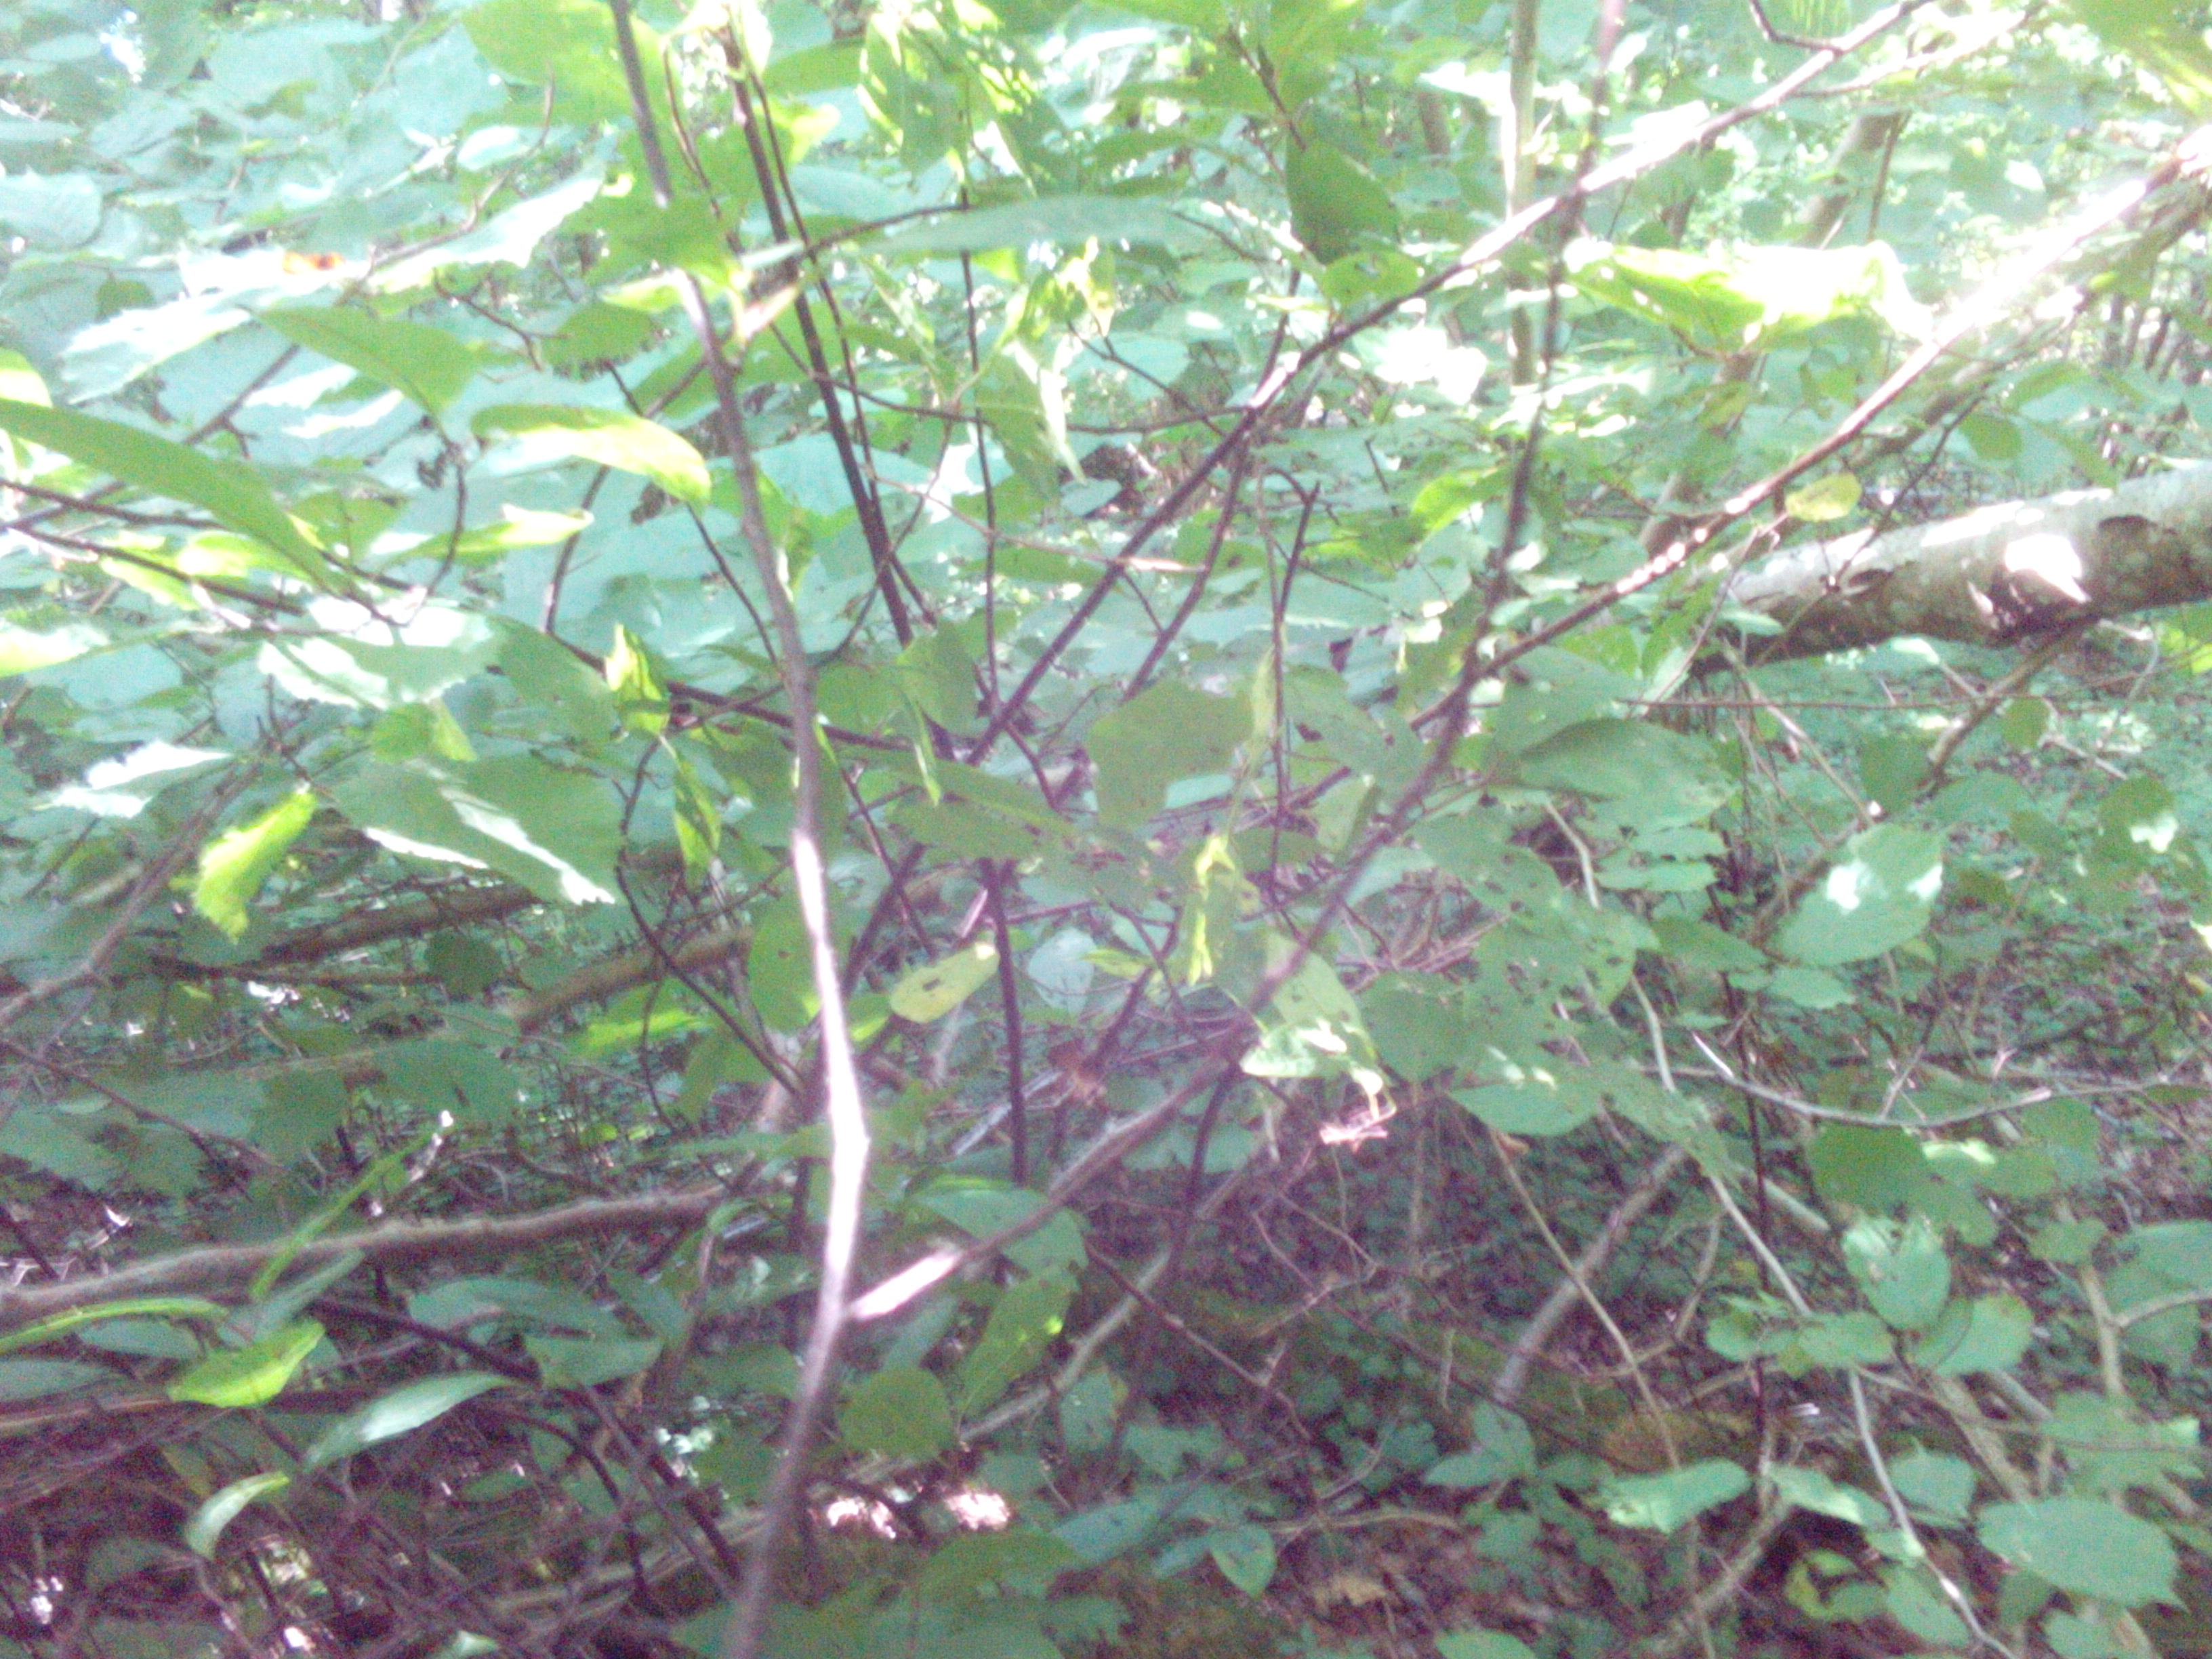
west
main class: Woodland
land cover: Broadleaved woodland
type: non-riverine alder, birch or aspen forest
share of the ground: > 75 %
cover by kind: broadleaved forest trees 95 %, herbaceous plants 5 %
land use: Forestry
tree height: > 5 m
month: August
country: LV
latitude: 56.4992
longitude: 21.3632
